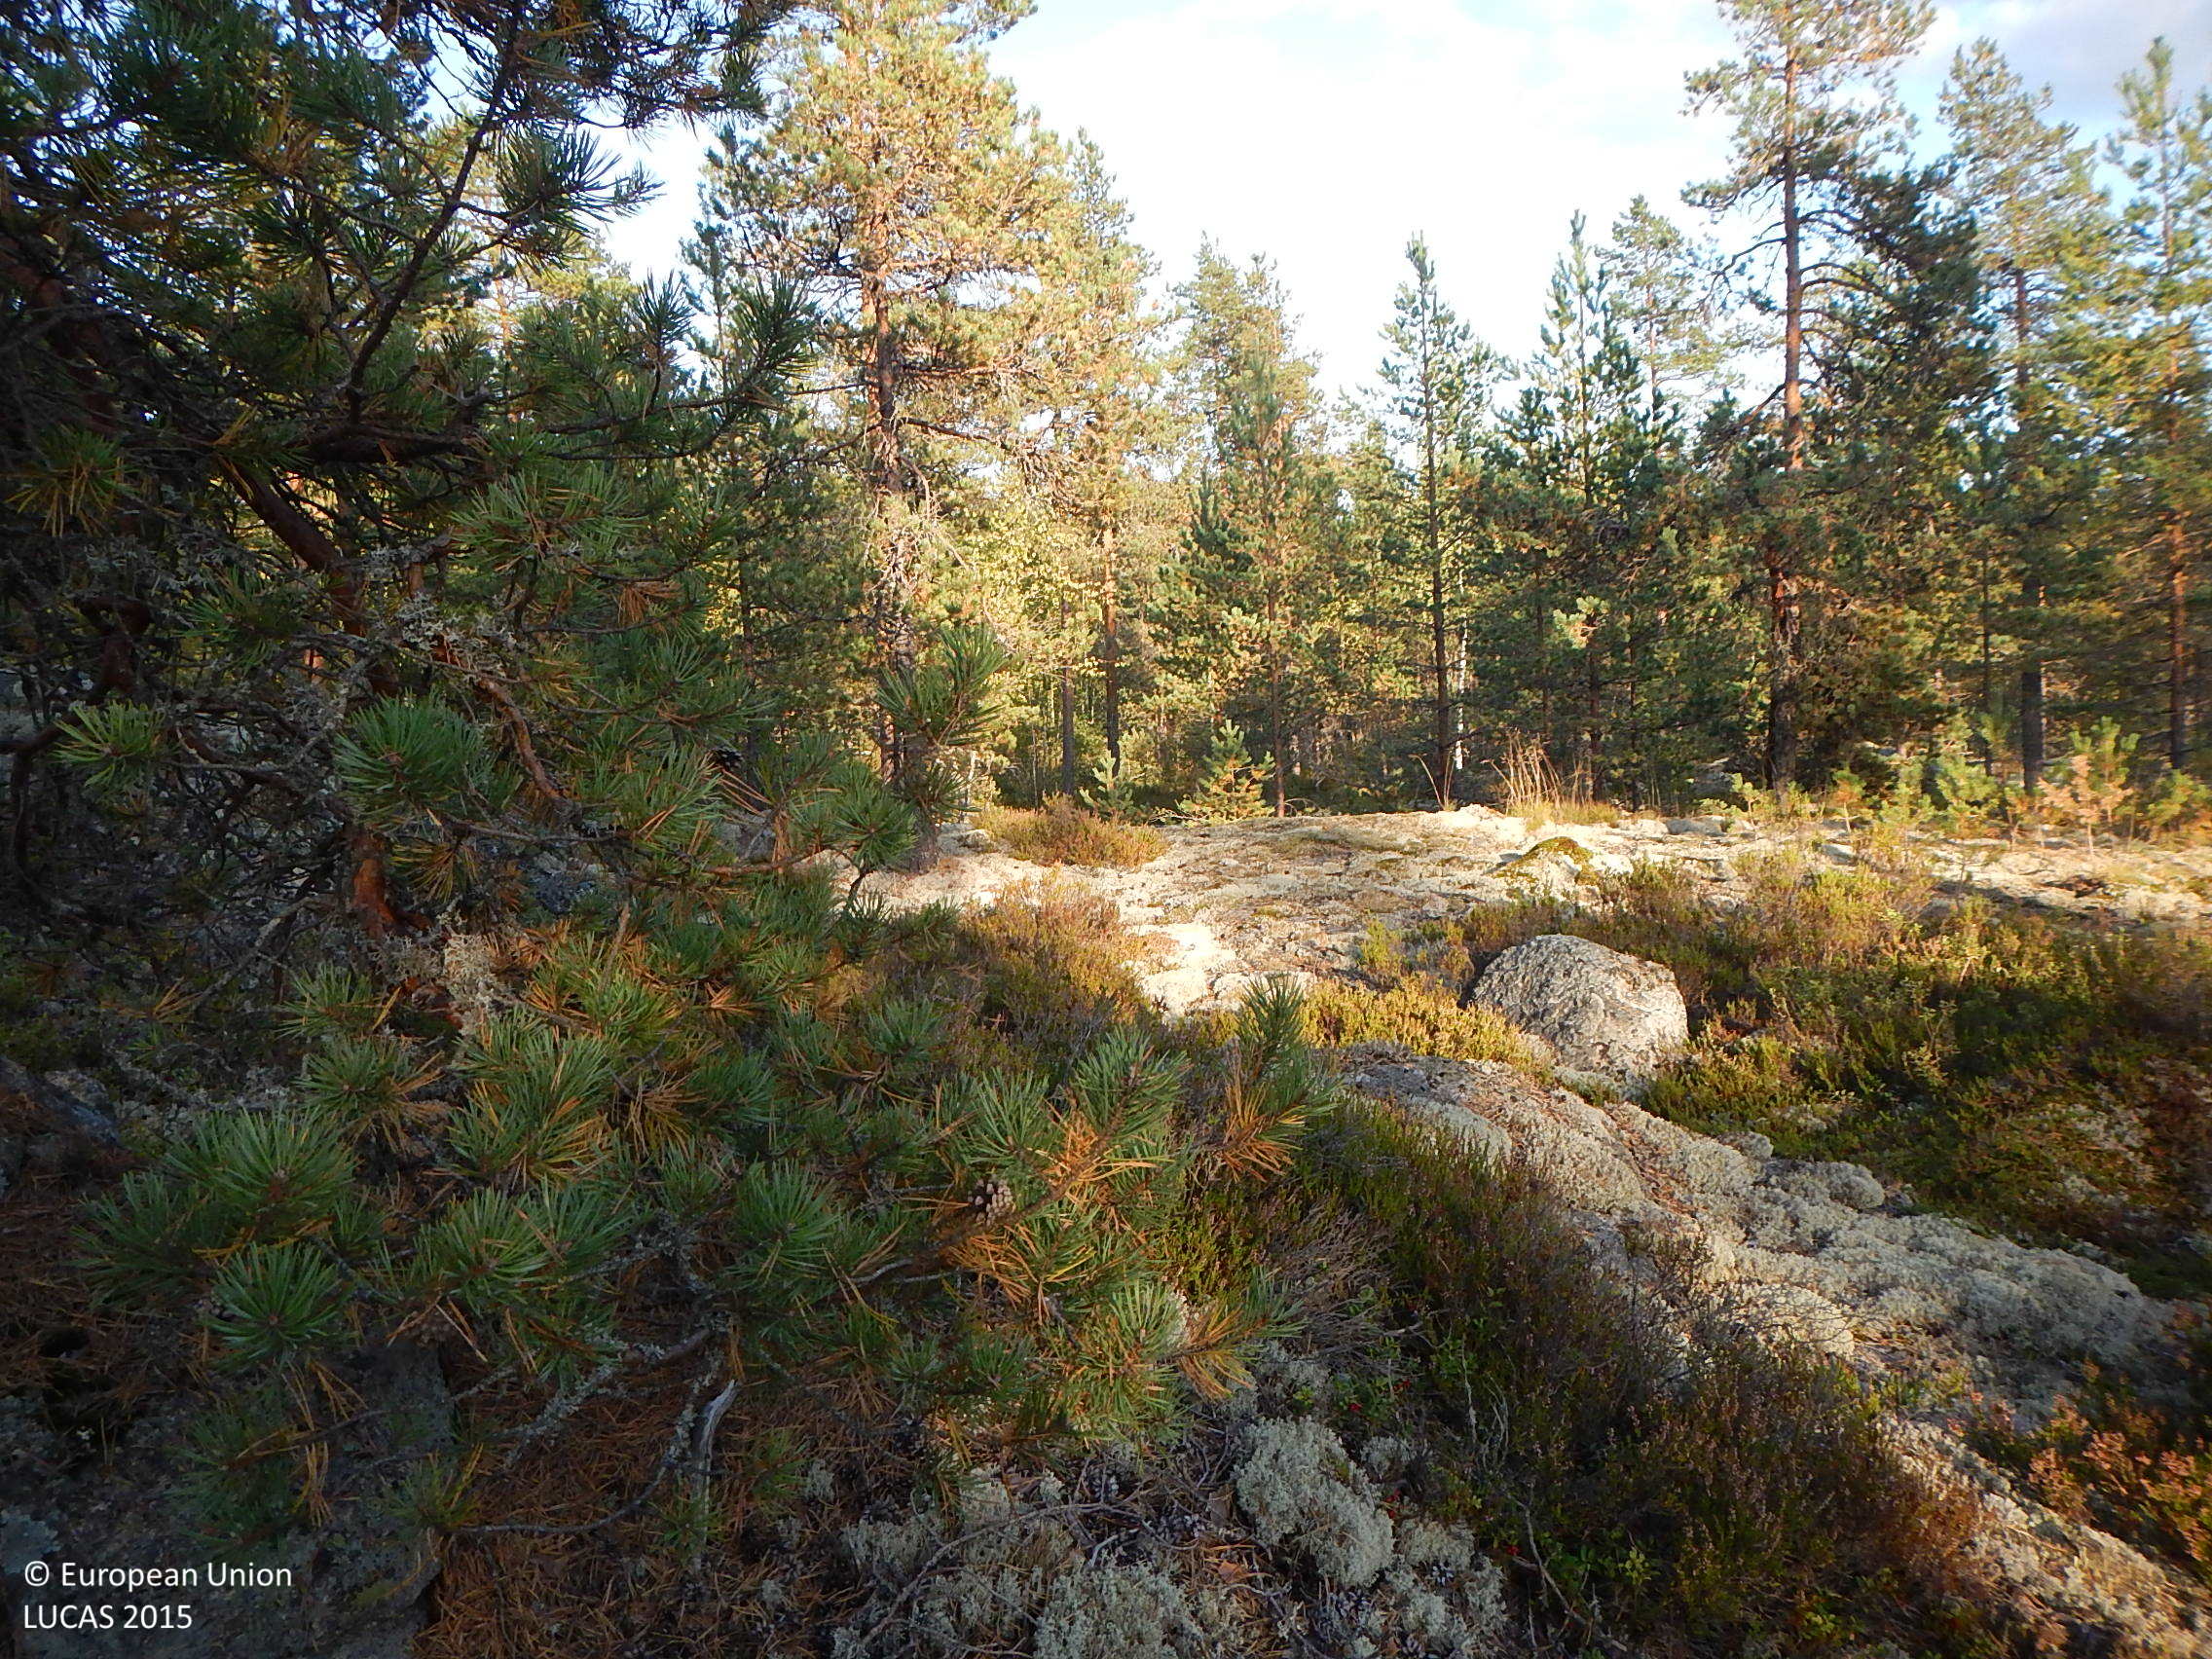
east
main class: Woodland
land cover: Pine dominated coniferous woodland
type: boreal forest
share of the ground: 25 - 50 %
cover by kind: coniferous forest trees 40 %, lichens and mosses 40 %, shrubs 10 %, consolidated bare surface 10 %
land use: Forestry
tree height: > 5 m
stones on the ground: < 10 %
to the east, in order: Pine dominated coniferous woodland; Rock outcrops; Pine dominated coniferous woodland; Rock outcrops; Pine dominated coniferous woodland; Tracks; Pine dominated coniferous woodland
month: September
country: FI
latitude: 61.6371
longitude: 22.6508
